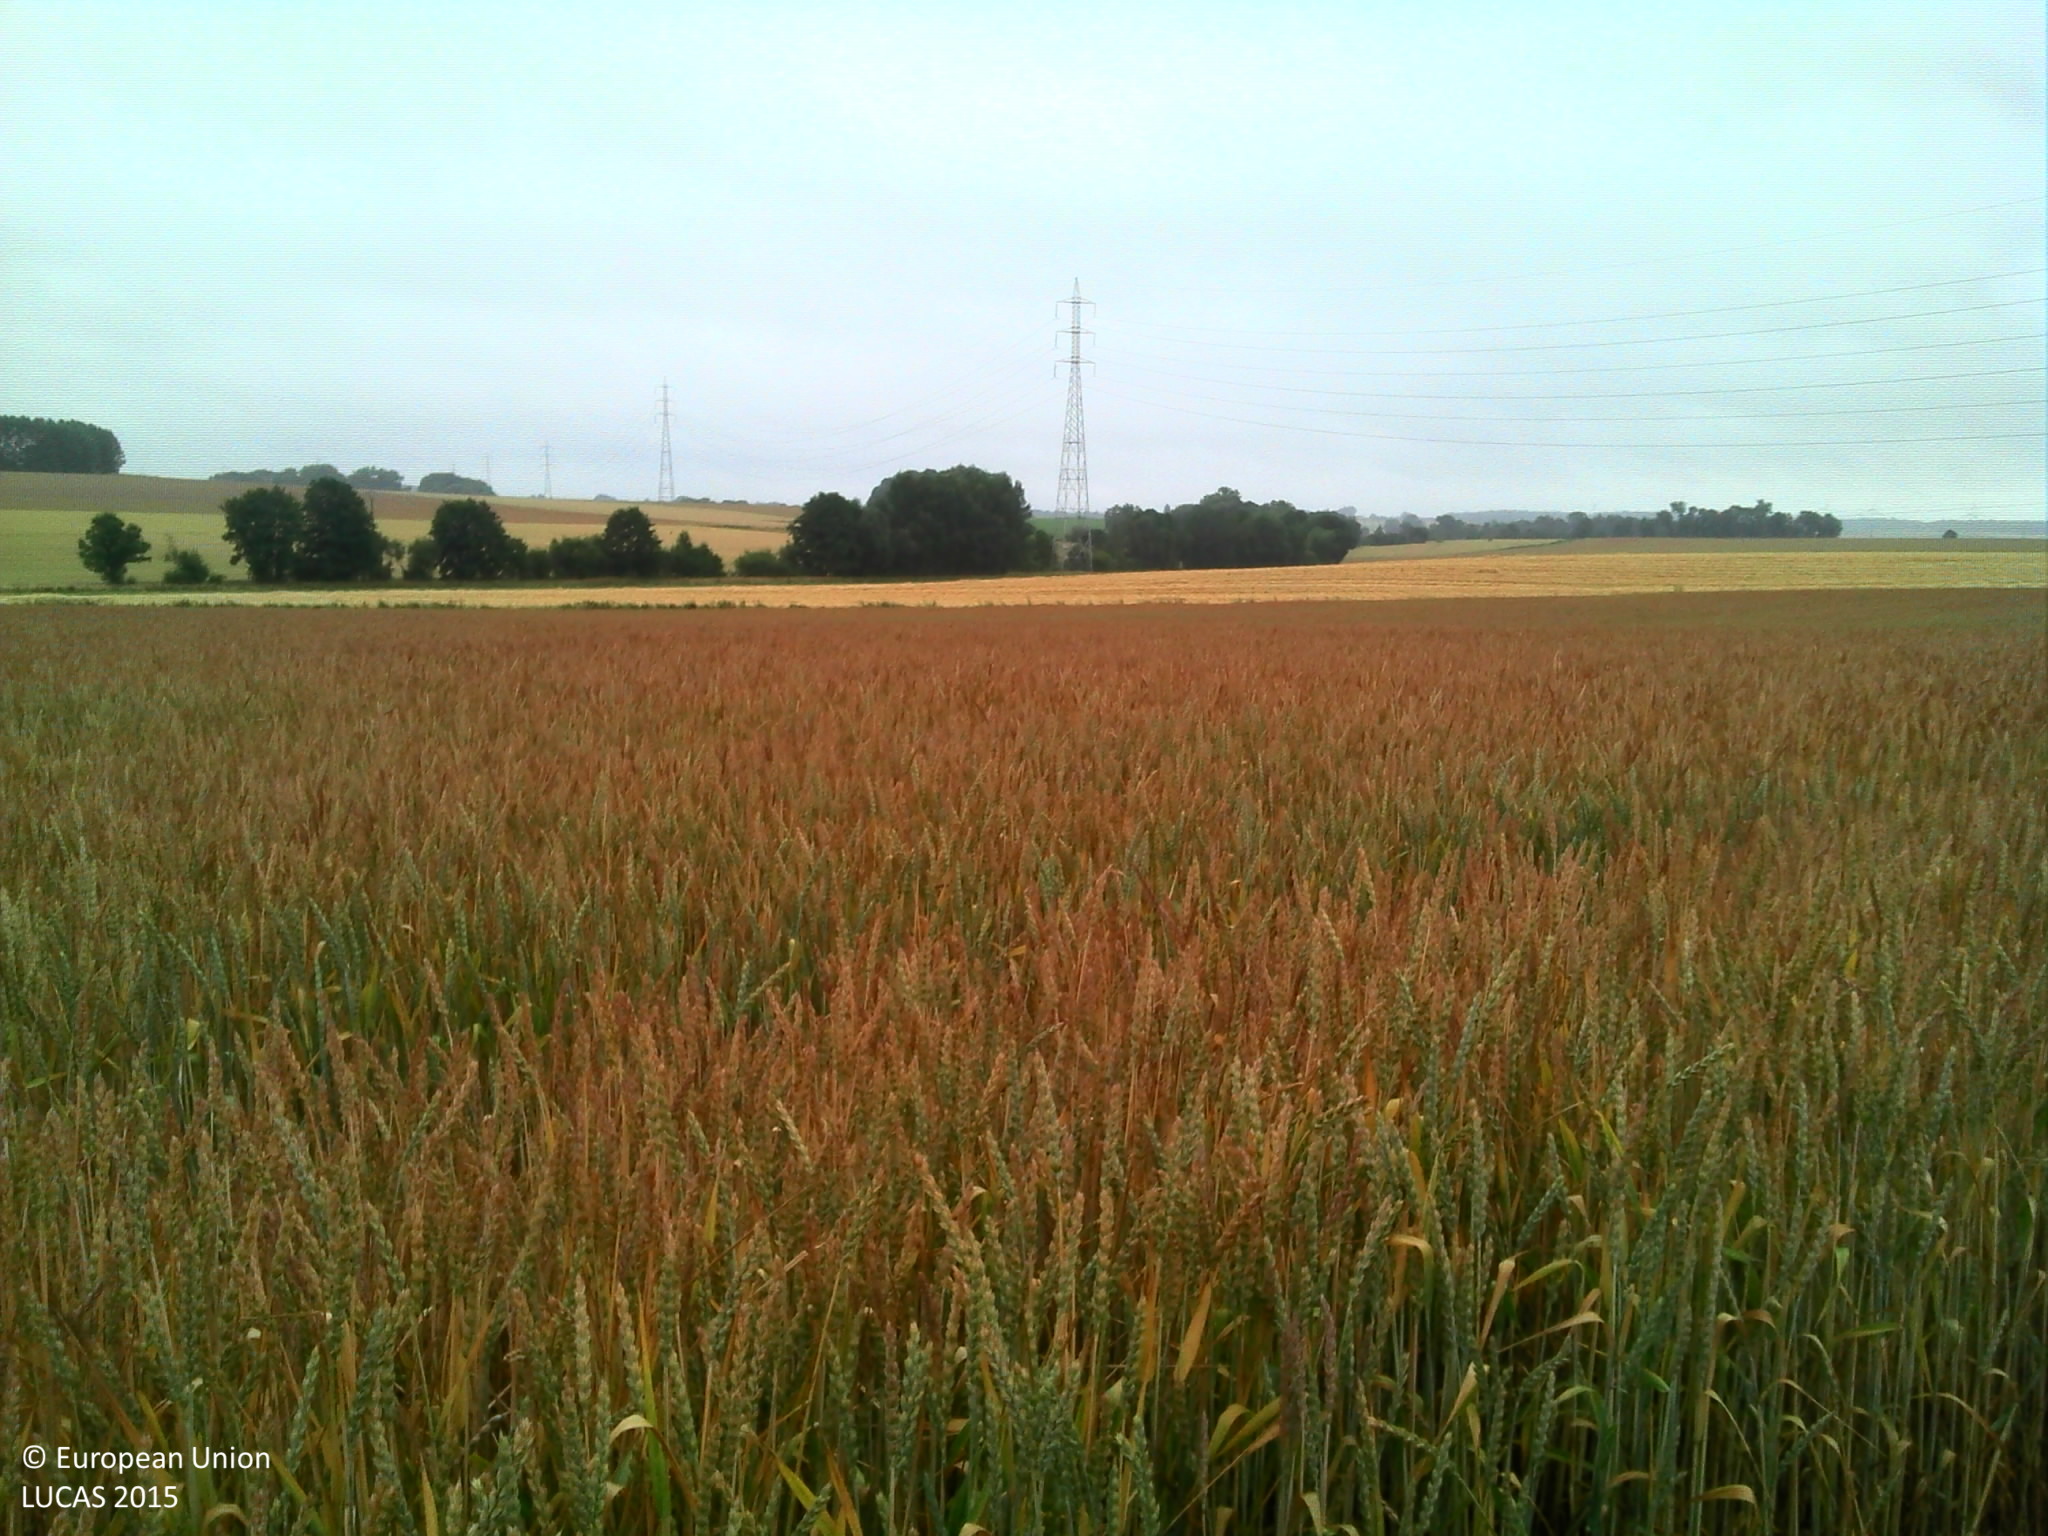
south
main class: Cropland
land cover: Common wheat
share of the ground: > 75 %
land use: Agriculture (excluding fallow land and kitchen gardens)
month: July
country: BE
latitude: 50.2794
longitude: 4.3683
